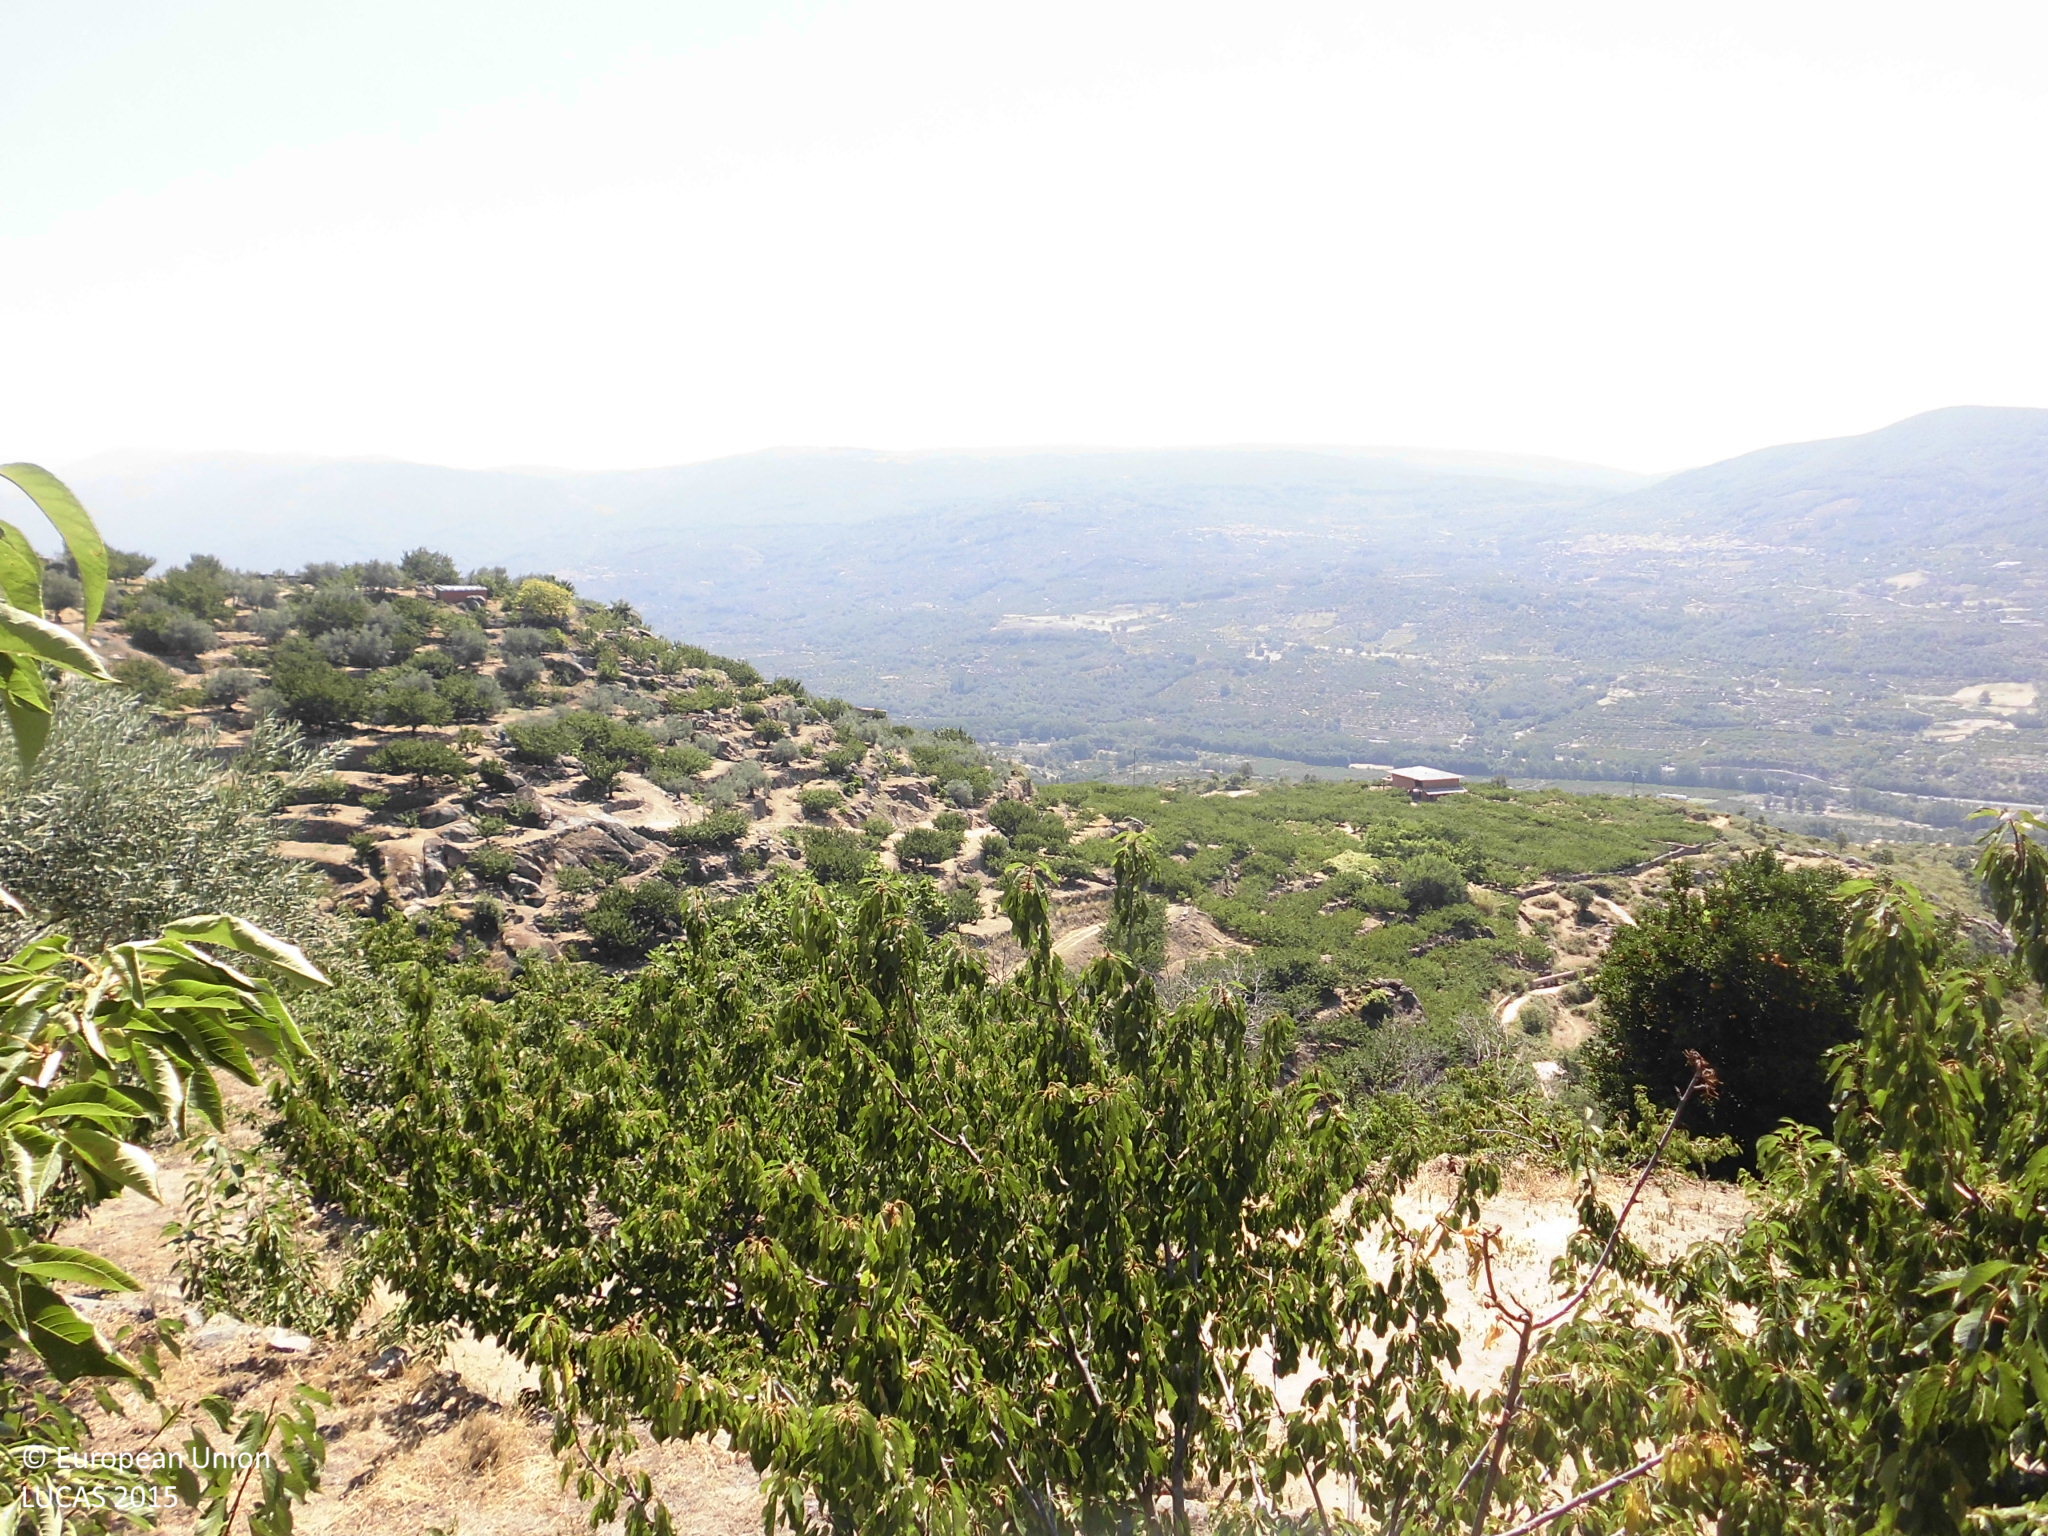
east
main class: Cropland
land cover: Cherry fruit
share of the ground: 25 - 50 %
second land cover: Grassland without tree/shrub cover
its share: > 75 %
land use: Agriculture (excluding fallow land and kitchen gardens)
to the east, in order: Cherry fruit; Grassland without tree/shrub cover; Cherry fruit; Broadleaved woodland; Rivers and streams; Groves; Tracks; Cherry fruit; Grassland with sparse tree/shrub cover
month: July
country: ES
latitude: 40.1307
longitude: -5.9486
